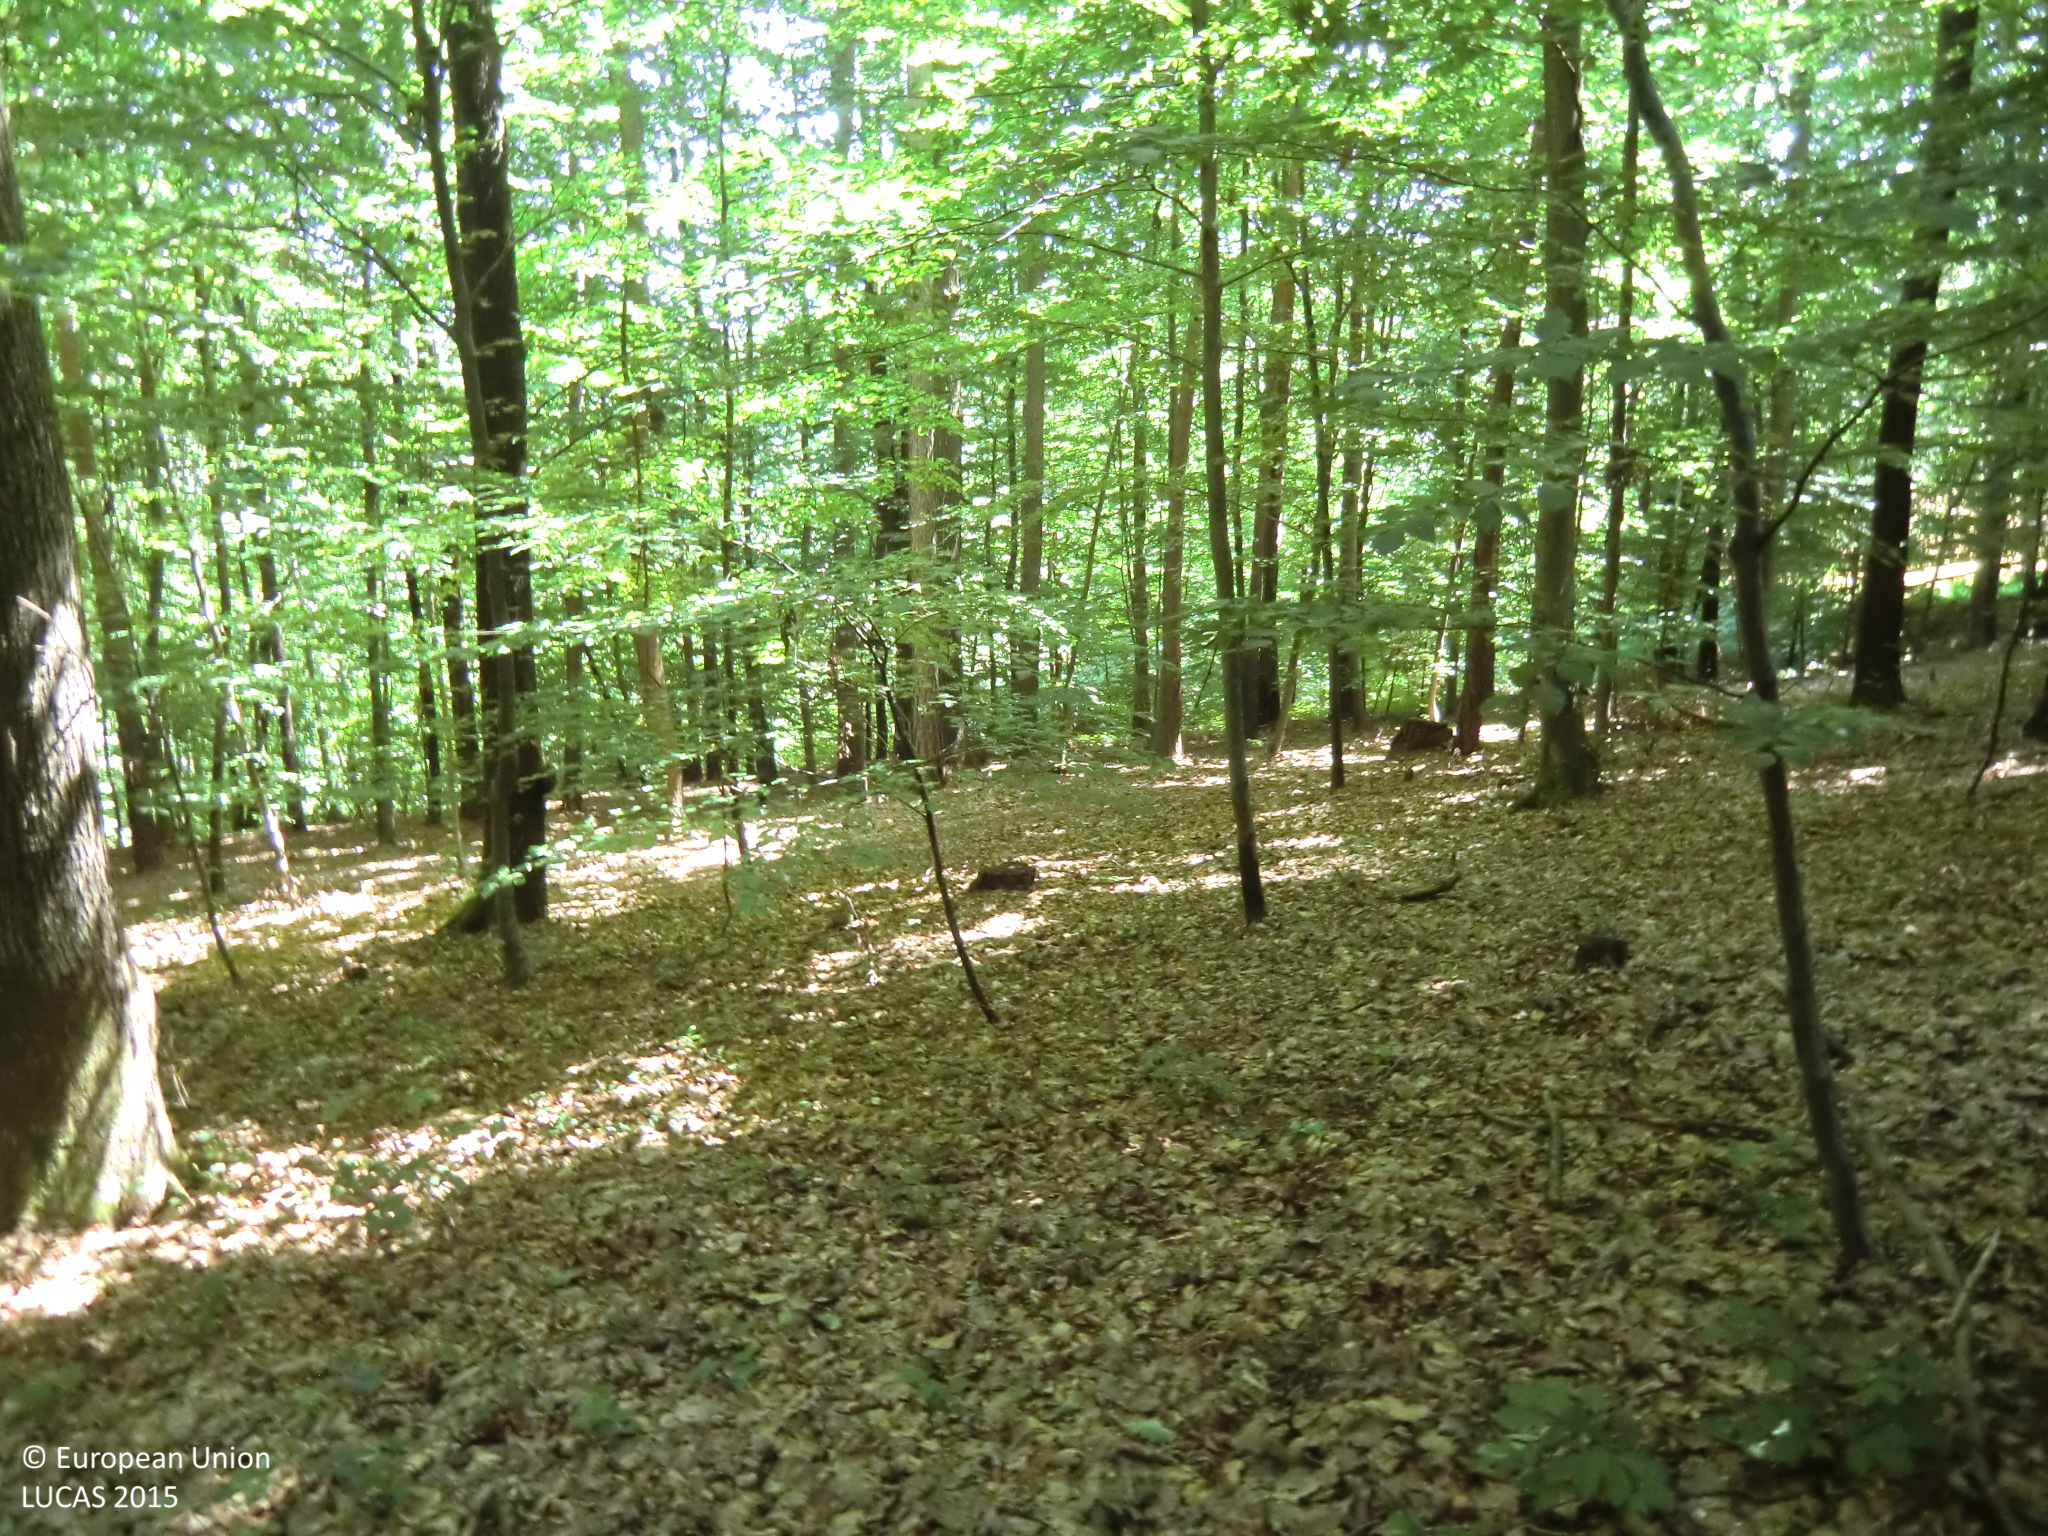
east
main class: Woodland
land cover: Pine dominated mixed woodland
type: hemiboreal forest and nemoral coniferous forest and mixed broadleaved-coniferous forest
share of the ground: > 75 %
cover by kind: broadleaved forest trees 65 %, coniferous forest trees 25 %, unconsolidated bare surface 10 %
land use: Forestry
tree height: > 5 m
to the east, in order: Pine dominated mixed woodland; Broadleaved woodland; Spruce dominated coniferous woodland; Spruce dominated mixed woodland
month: July
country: AT
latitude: 47.0670
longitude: 15.6756
